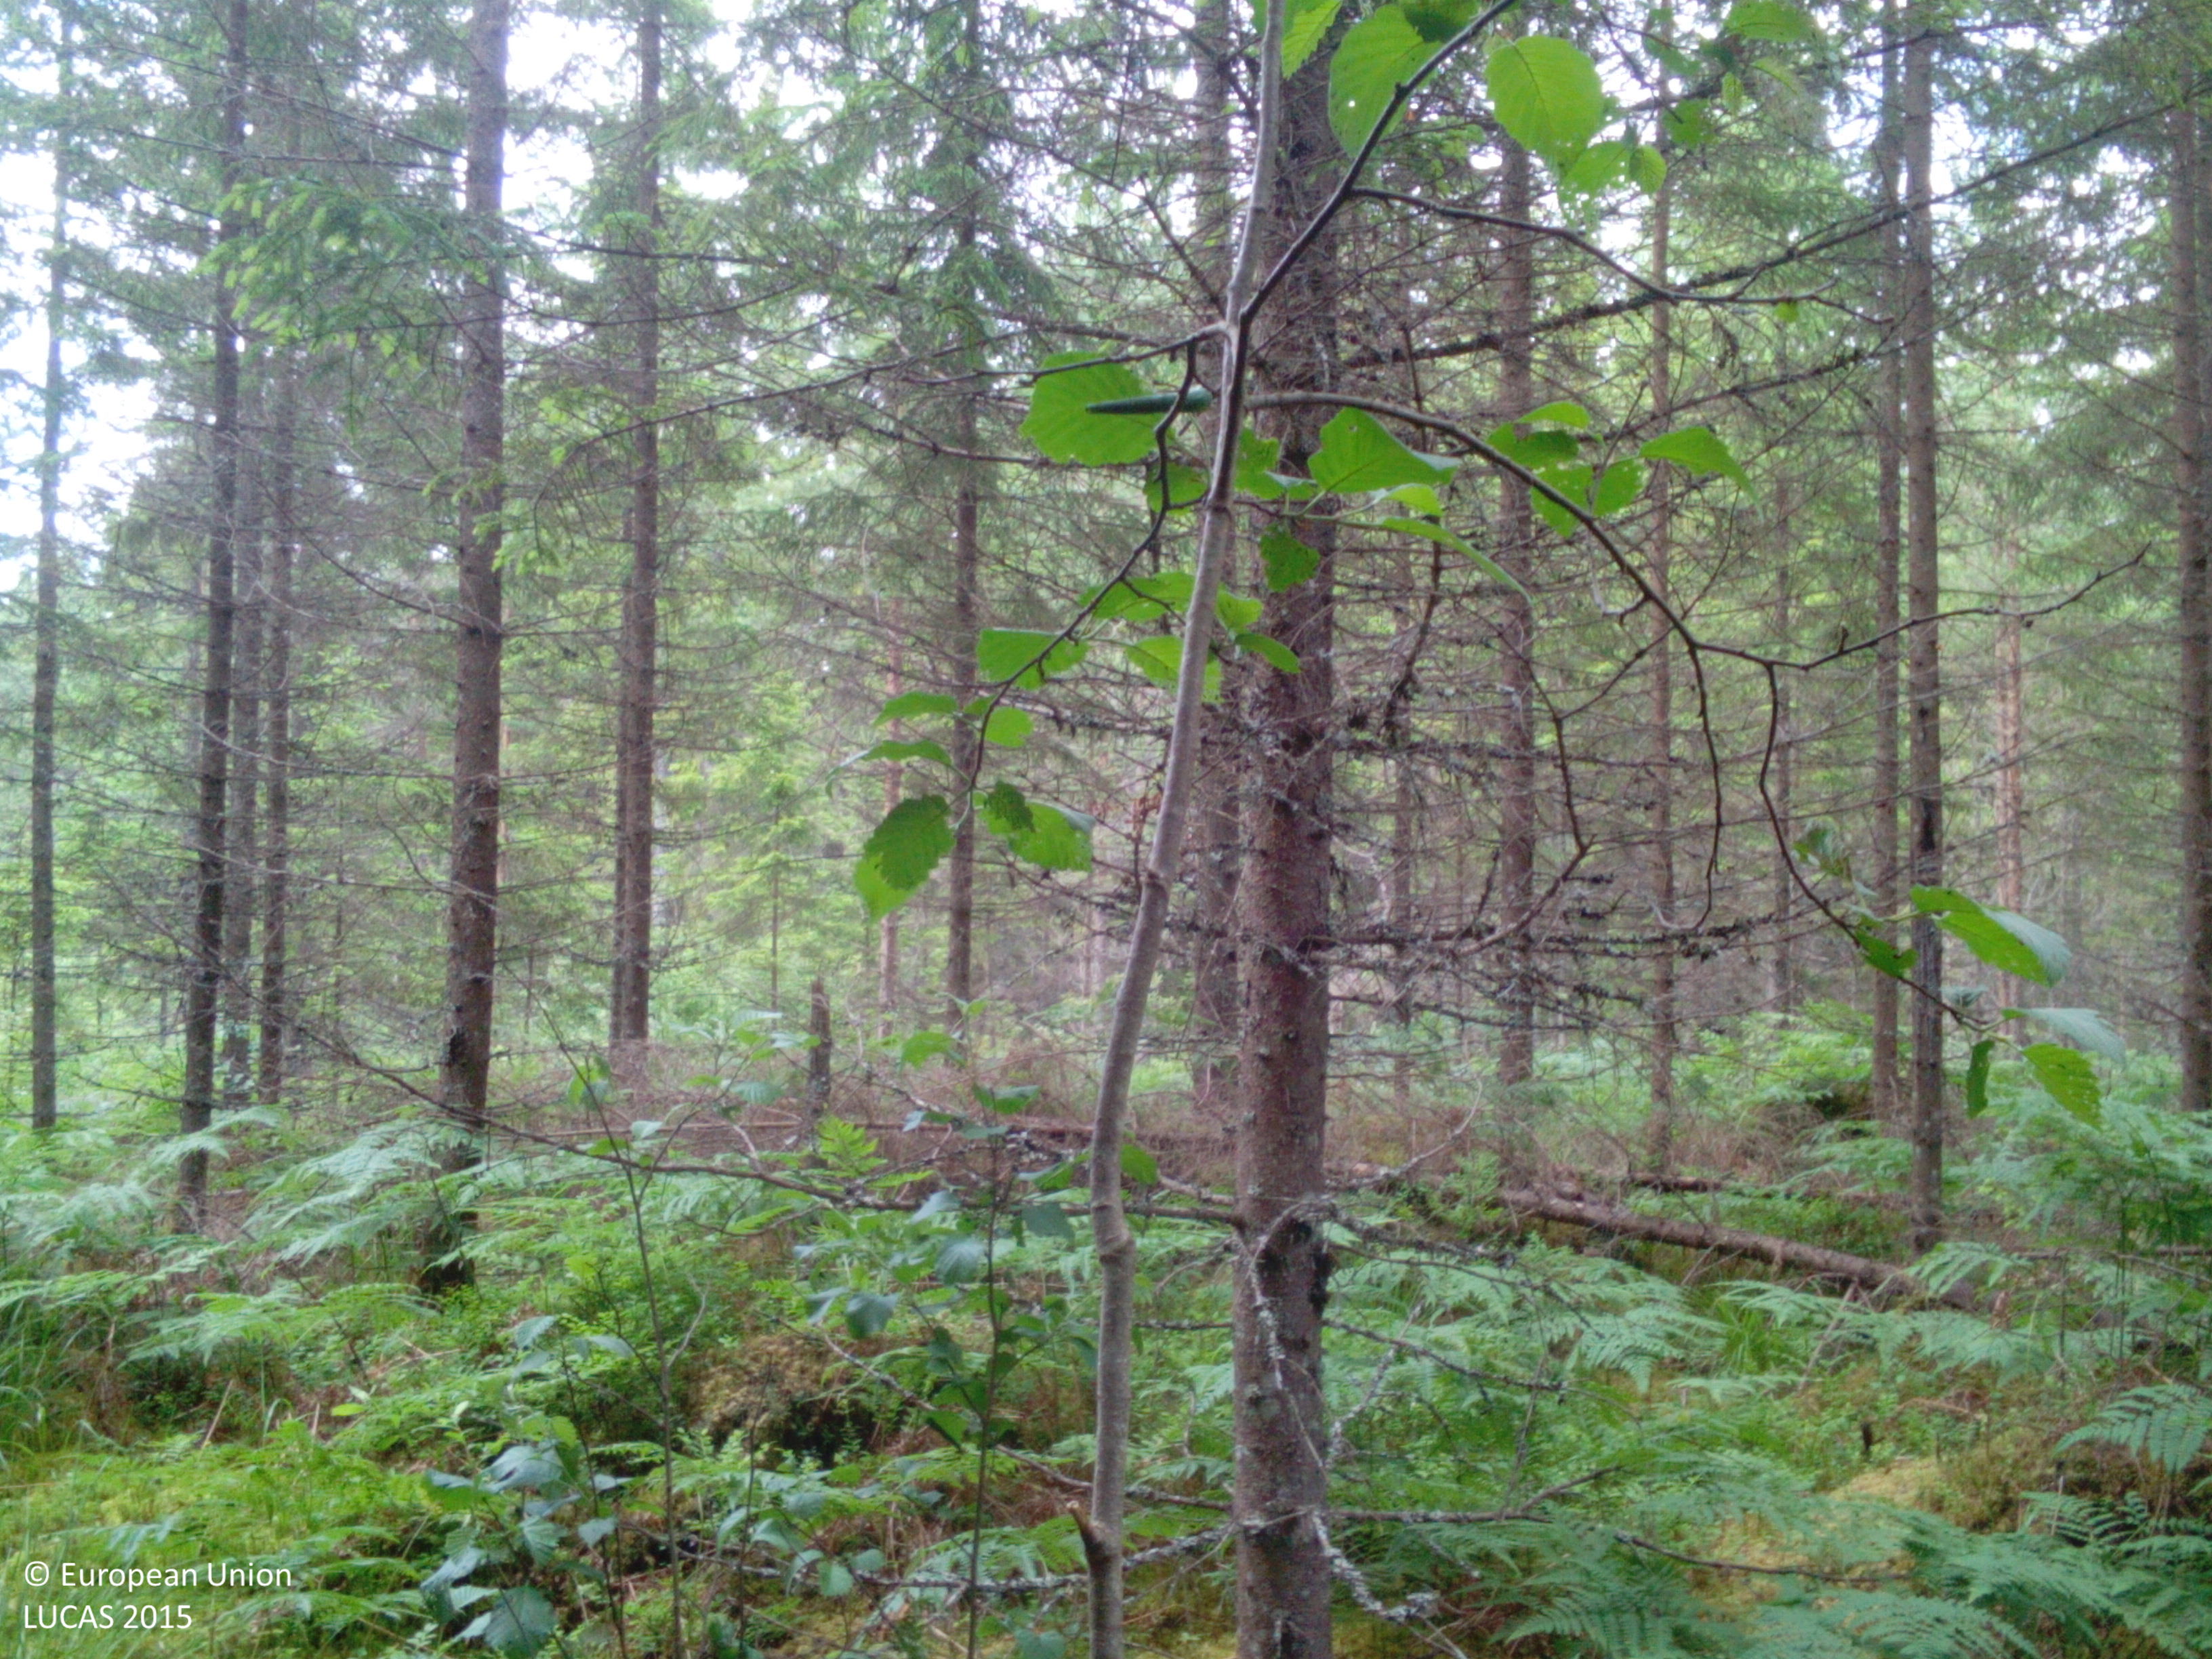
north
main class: Woodland
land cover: Spruce dominated coniferous woodland
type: hemiboreal forest and nemoral coniferous forest and mixed broadleaved-coniferous forest
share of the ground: > 75 %
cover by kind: coniferous forest trees 80 %, herbaceous plants 10 %, broadleaved forest trees 5 %, lichens and mosses 5 %
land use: Forestry
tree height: > 5 m
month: July
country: LV
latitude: 57.0121
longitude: 22.3209
